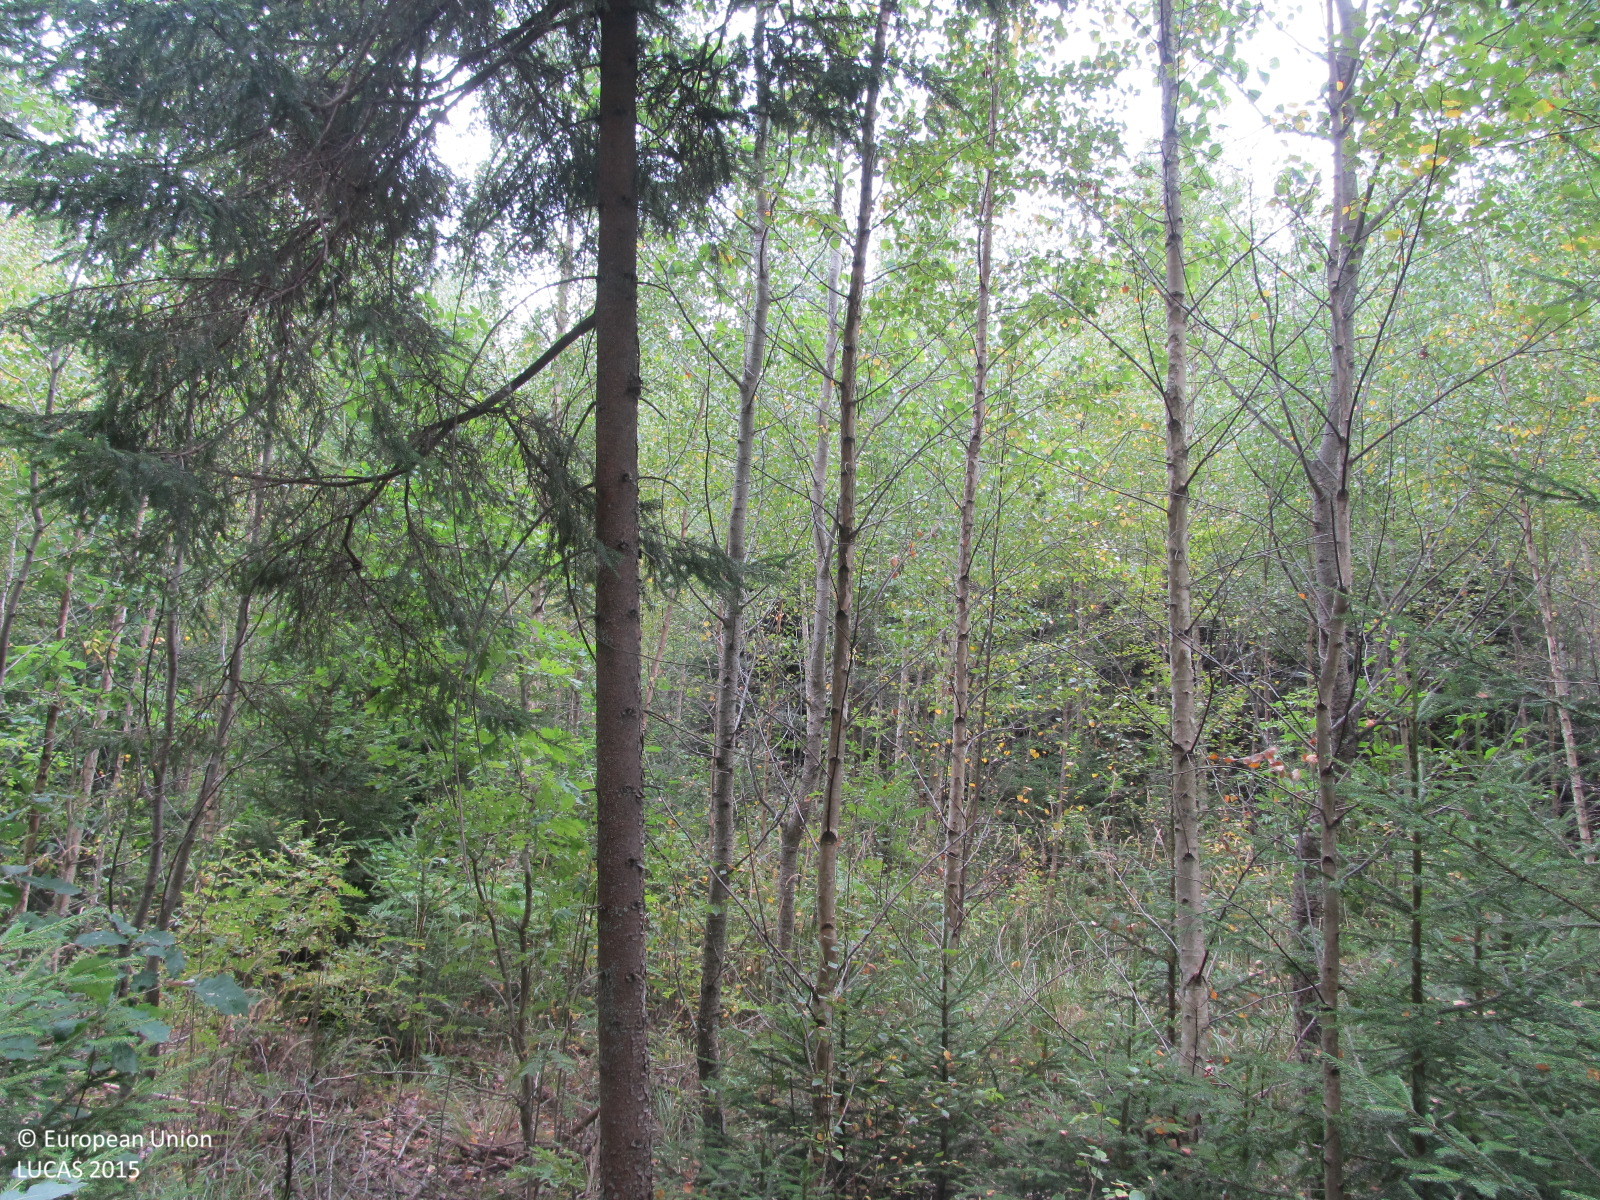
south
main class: Woodland
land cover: Spruce dominated mixed woodland
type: hemiboreal forest and nemoral coniferous forest and mixed broadleaved-coniferous forest
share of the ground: > 75 %
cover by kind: coniferous forest trees 50 %, broadleaved forest trees 30 %, shrubs 10 %, herbaceous plants 5 %, lichens and mosses 5 %
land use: Forestry
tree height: > 5 m
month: August
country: LT
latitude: 55.6516
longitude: 22.9890
